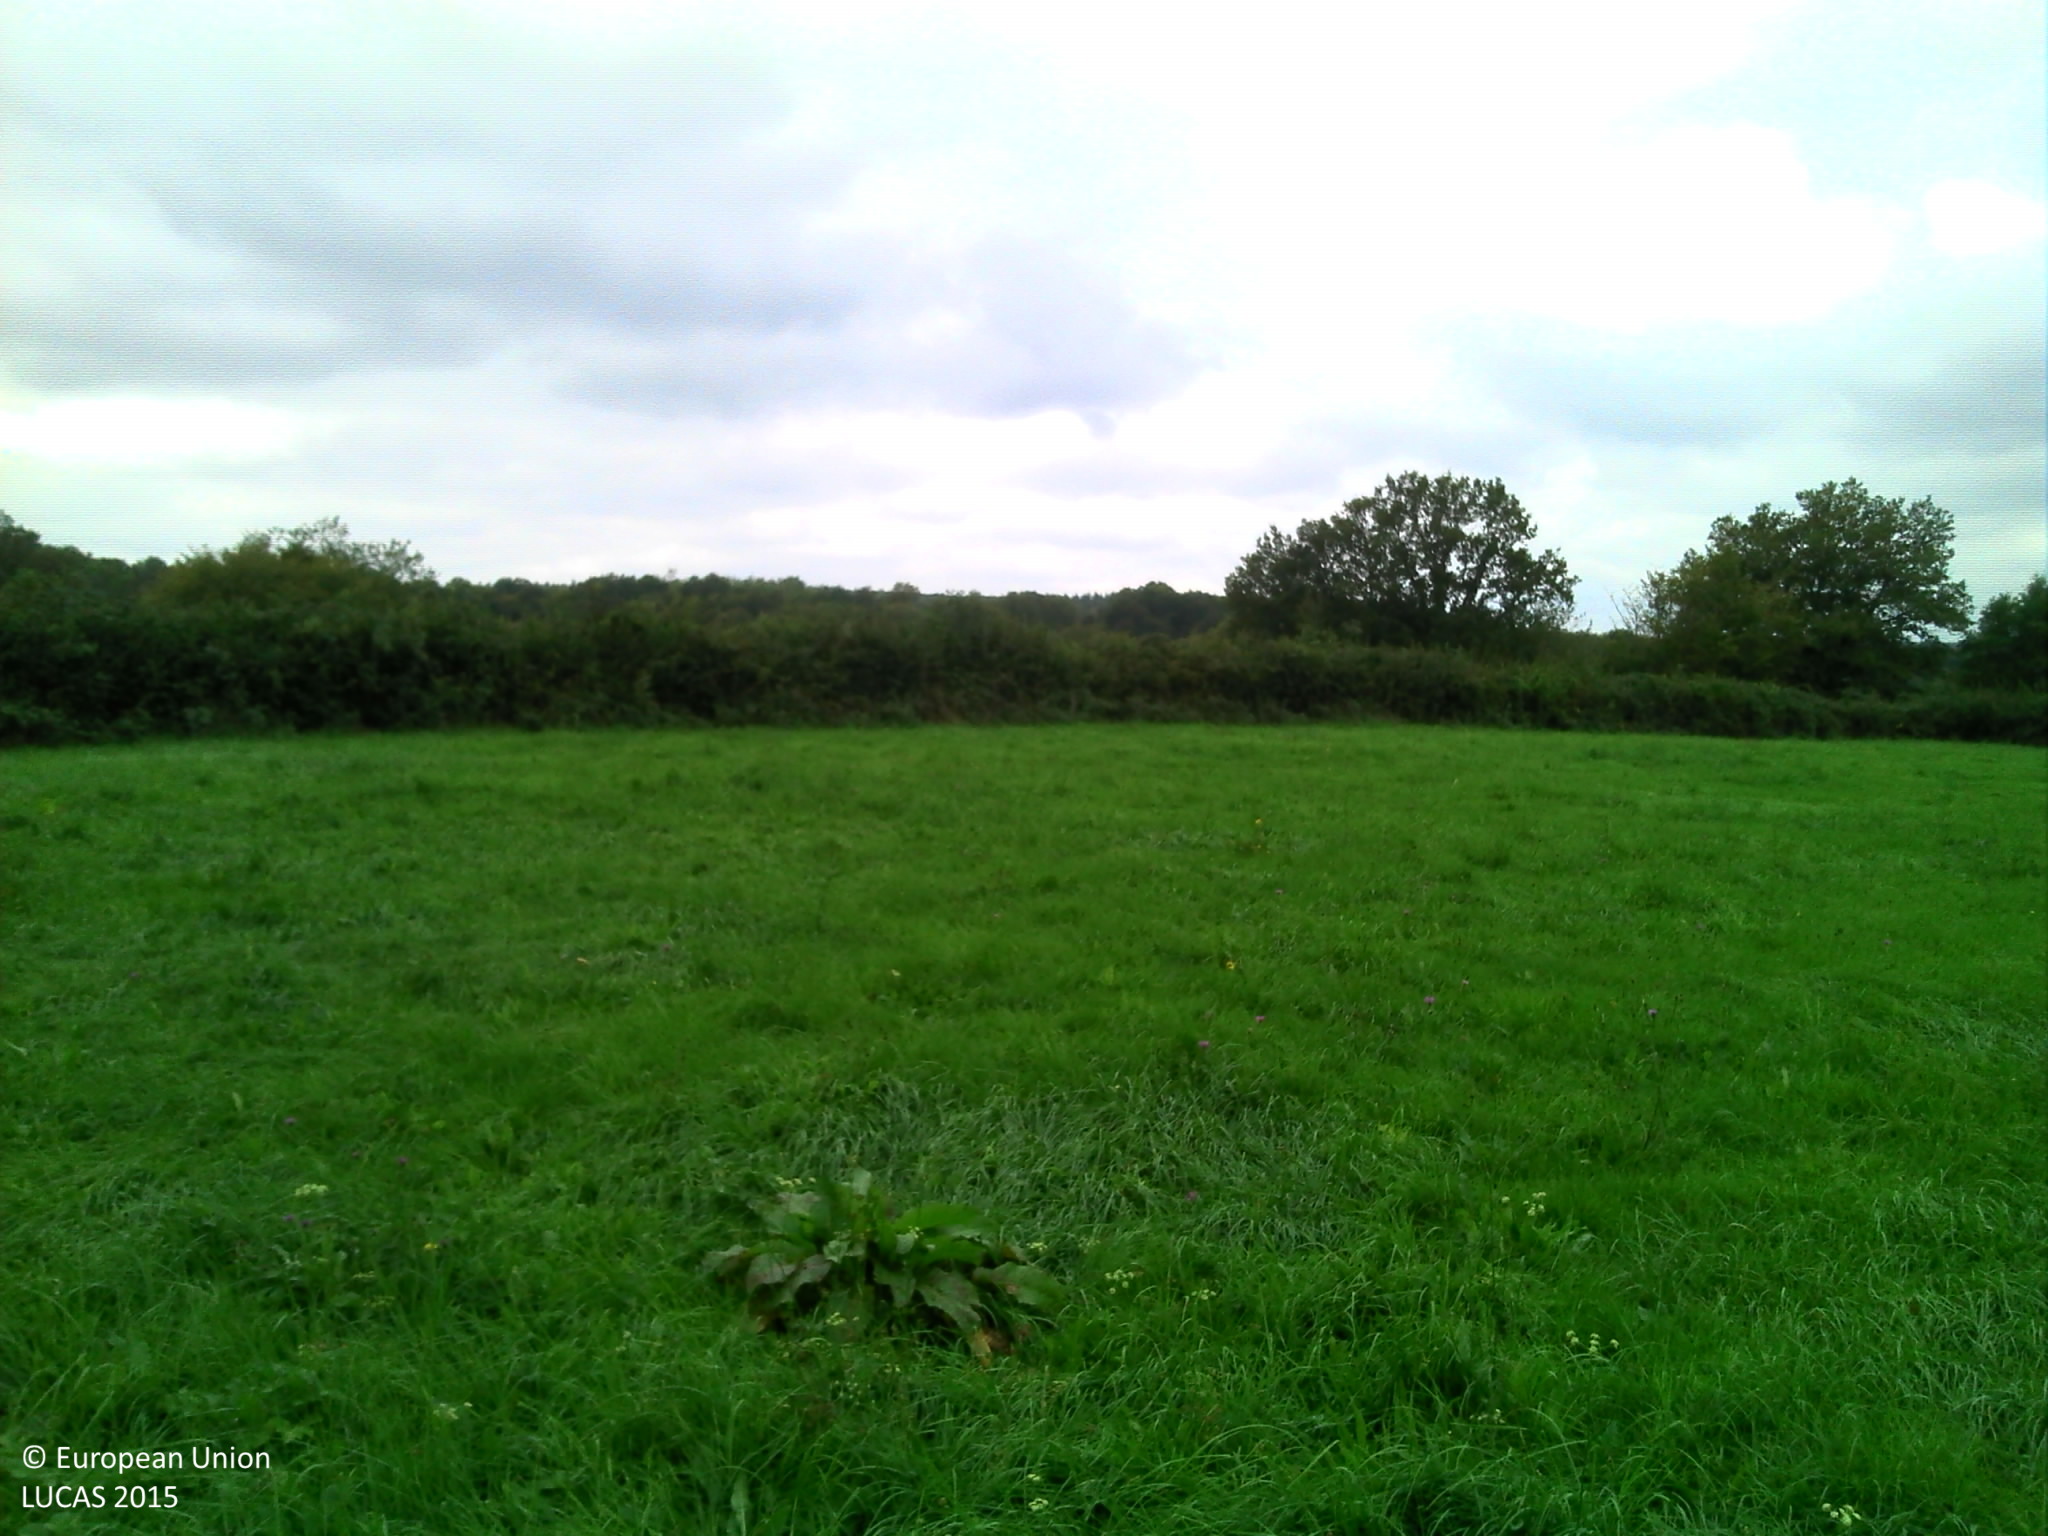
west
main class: Grassland
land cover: Grassland without tree/shrub cover
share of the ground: > 75 %
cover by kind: herbaceous plants 100 %
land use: Agriculture (excluding fallow land and kitchen gardens)
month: September
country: FR
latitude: 47.0724
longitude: 4.4294
